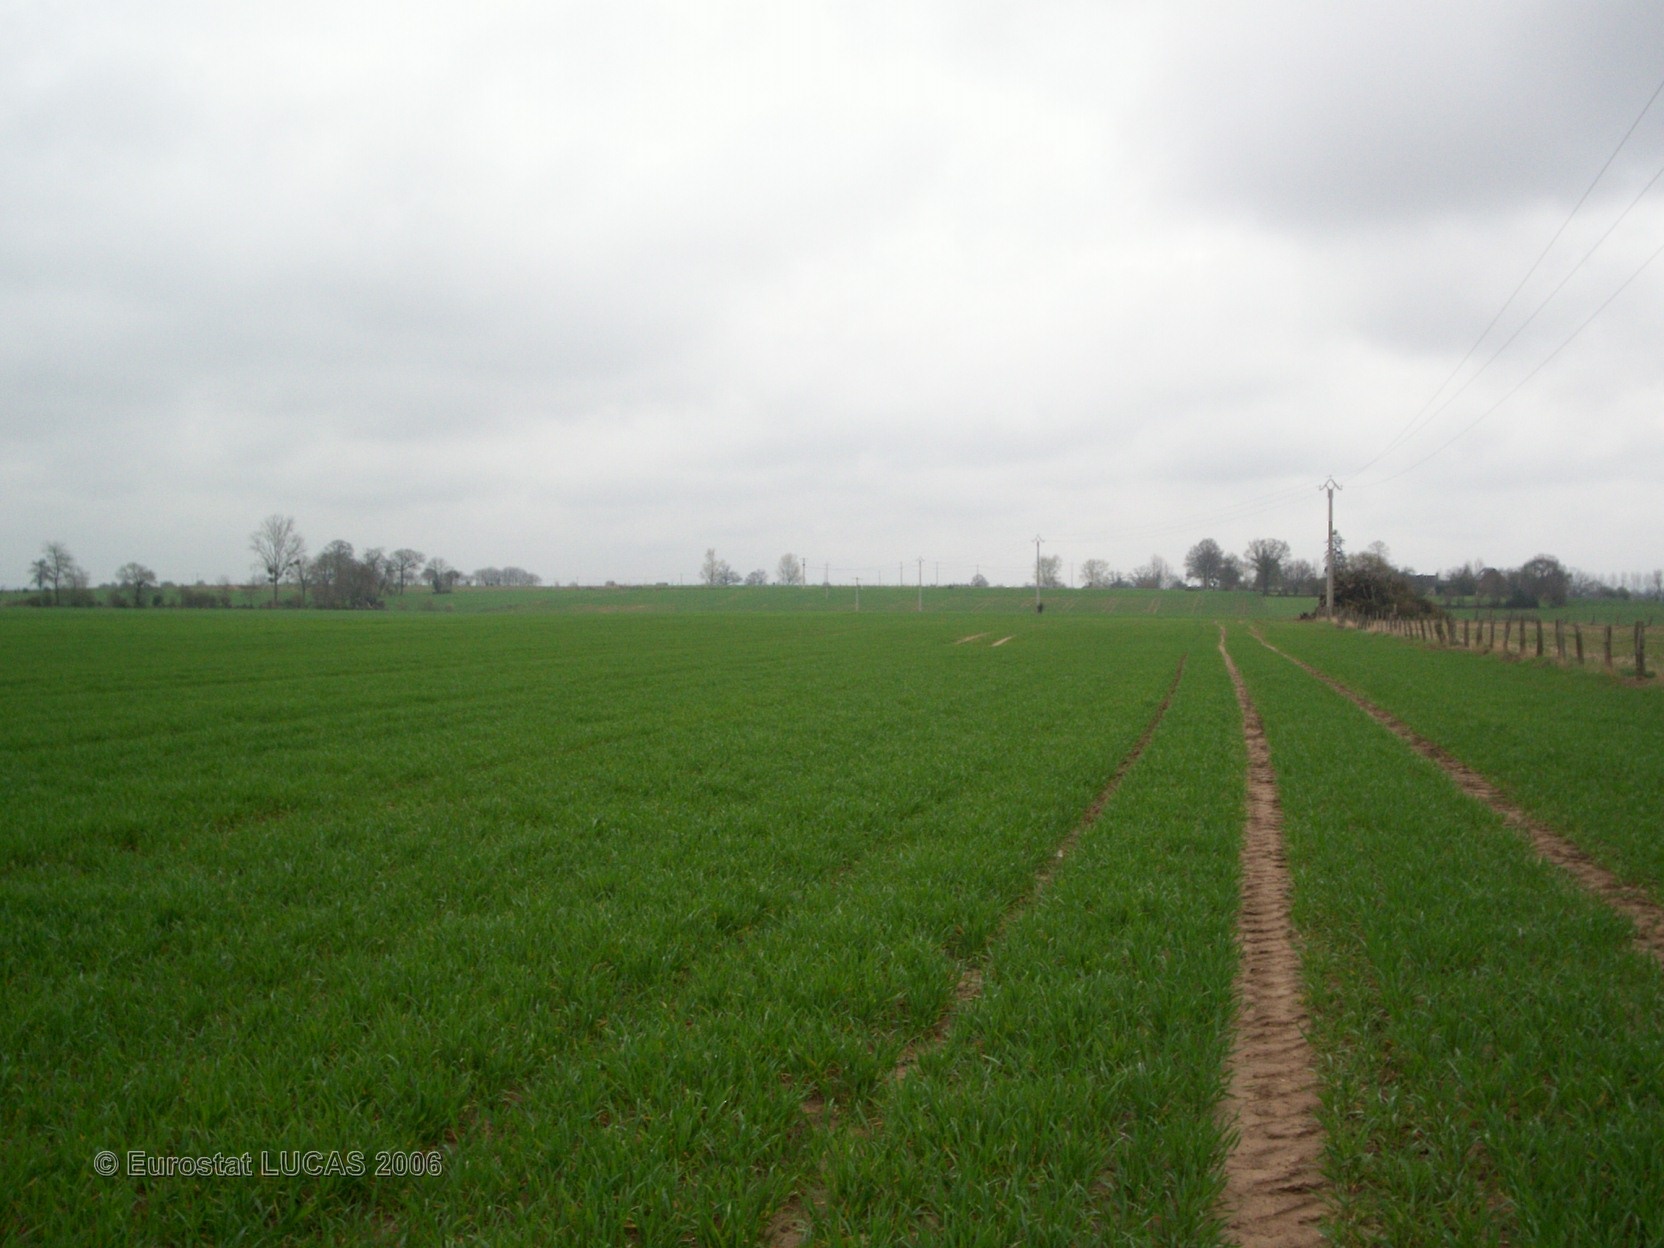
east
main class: Cropland
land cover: Common wheat
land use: Agriculture (excluding fallow land and kitchen gardens)
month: April
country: FR
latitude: 48.4450
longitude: -0.7035
